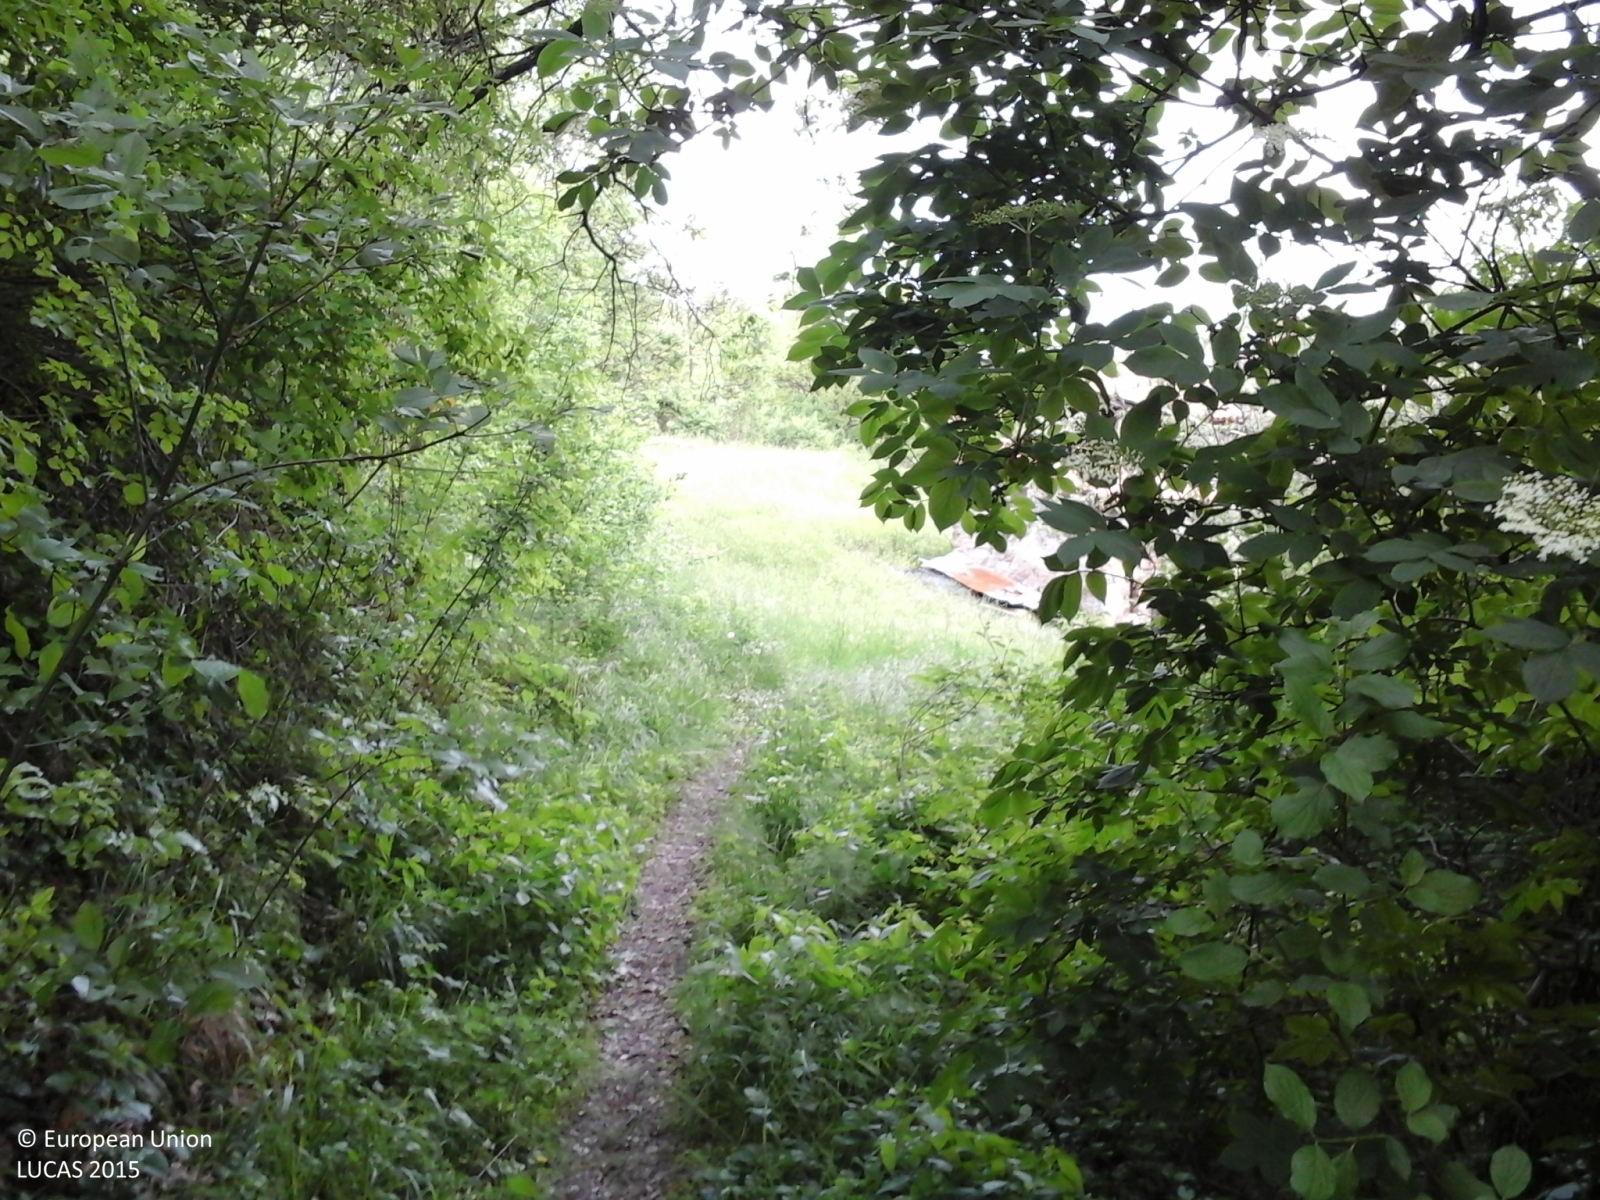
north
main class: Woodland
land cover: Broadleaved woodland
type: mesophytic deciduous forest
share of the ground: > 75 %
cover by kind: broadleaved forest trees 95 %, shrubs 5 %
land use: Forestry
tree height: > 5 m
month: May
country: IT
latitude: 44.8906
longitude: 9.5577
